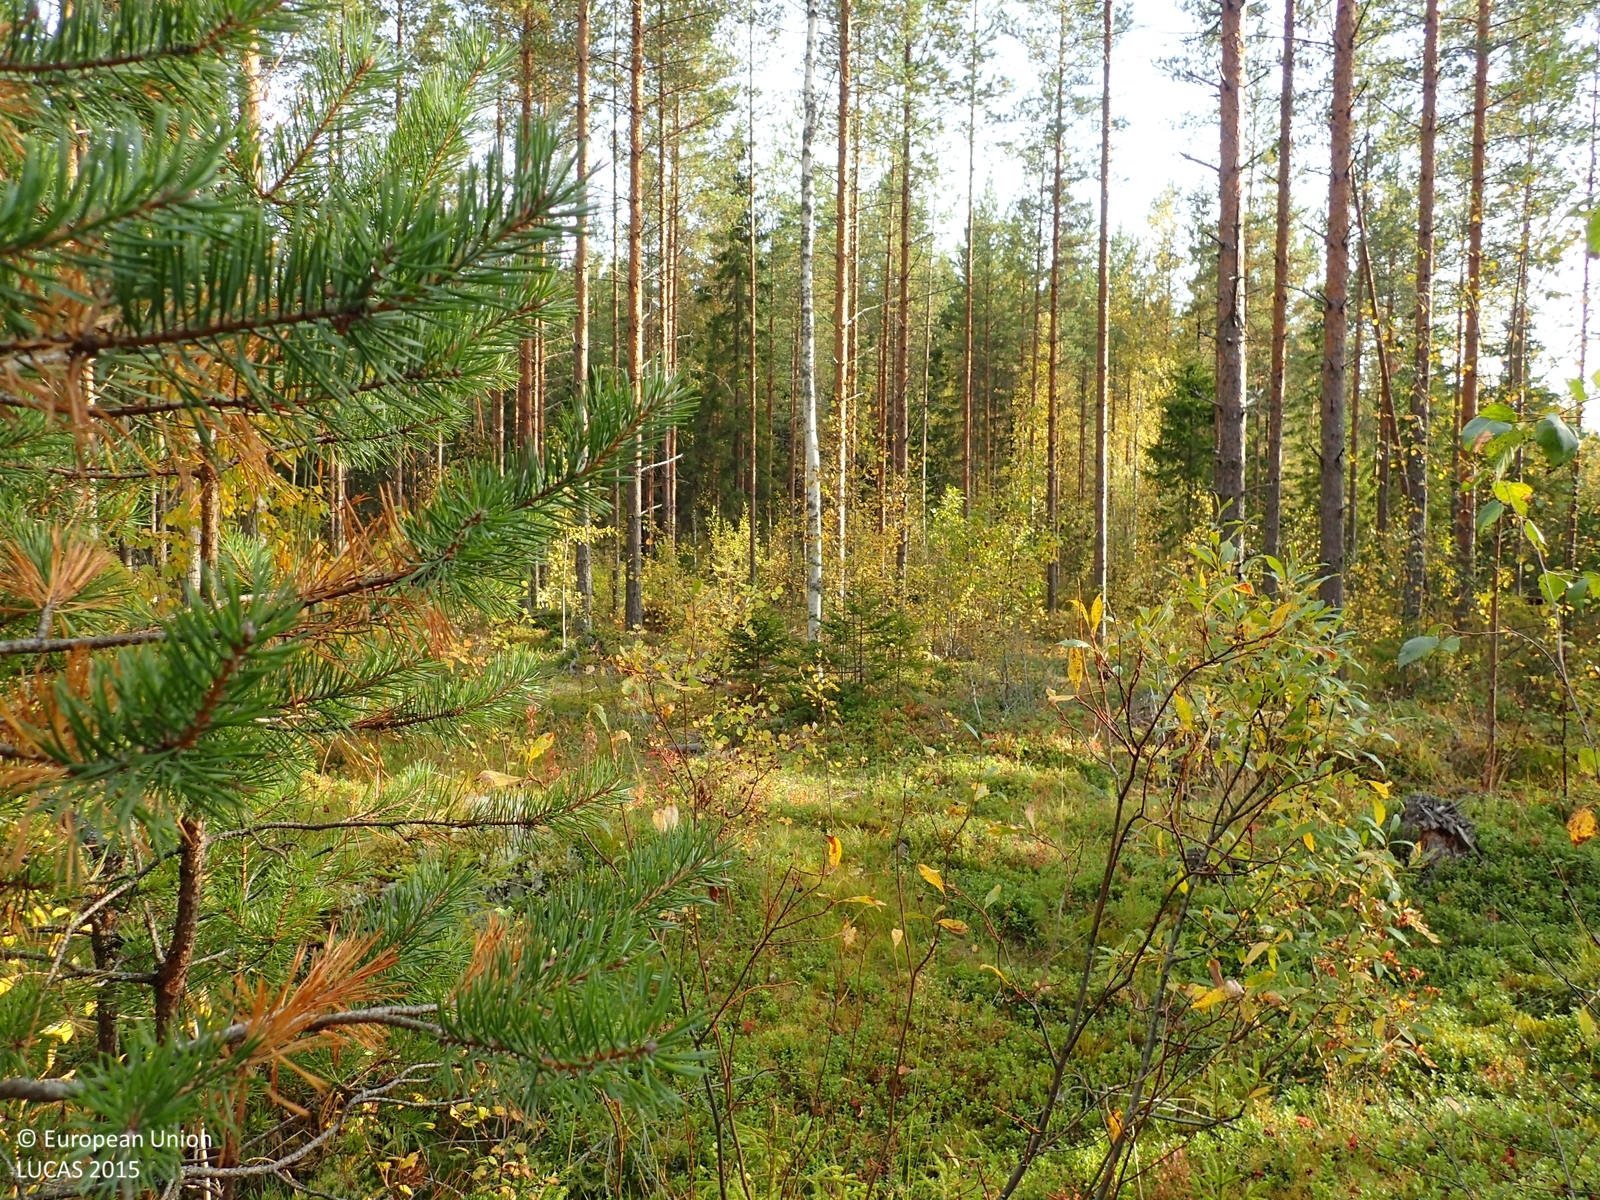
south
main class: Woodland
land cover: Pine dominated mixed woodland
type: boreal forest
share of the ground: 50 - 75 %
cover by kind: shrubs 40 %, broadleaved forest trees 35 %, coniferous forest trees 15 %, lichens and mosses 5 %, consolidated bare surface 5 %
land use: Forestry
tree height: < 5 m
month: September
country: FI
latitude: 63.0316
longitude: 25.7464
